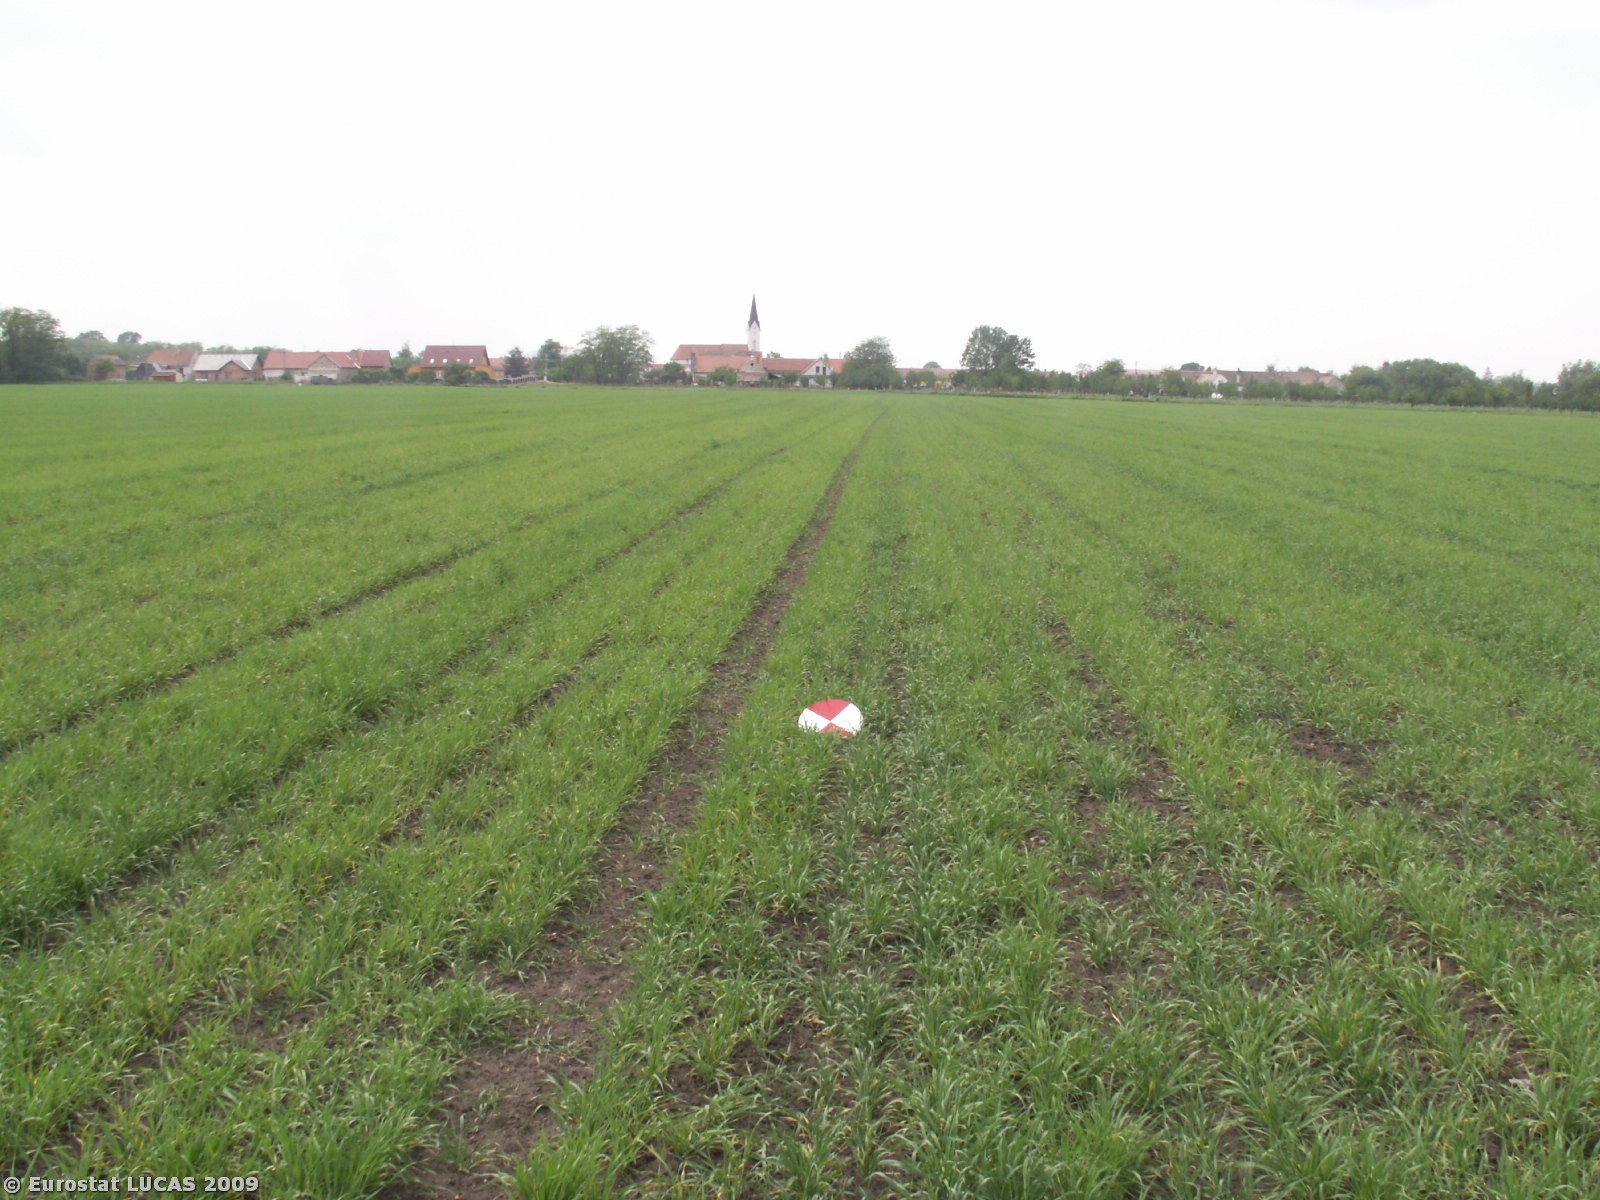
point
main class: Cropland
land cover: Barley
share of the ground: > 75 %
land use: Agriculture (excluding fallow land and kitchen gardens)
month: May
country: CZ
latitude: 48.8077
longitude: 16.5015
